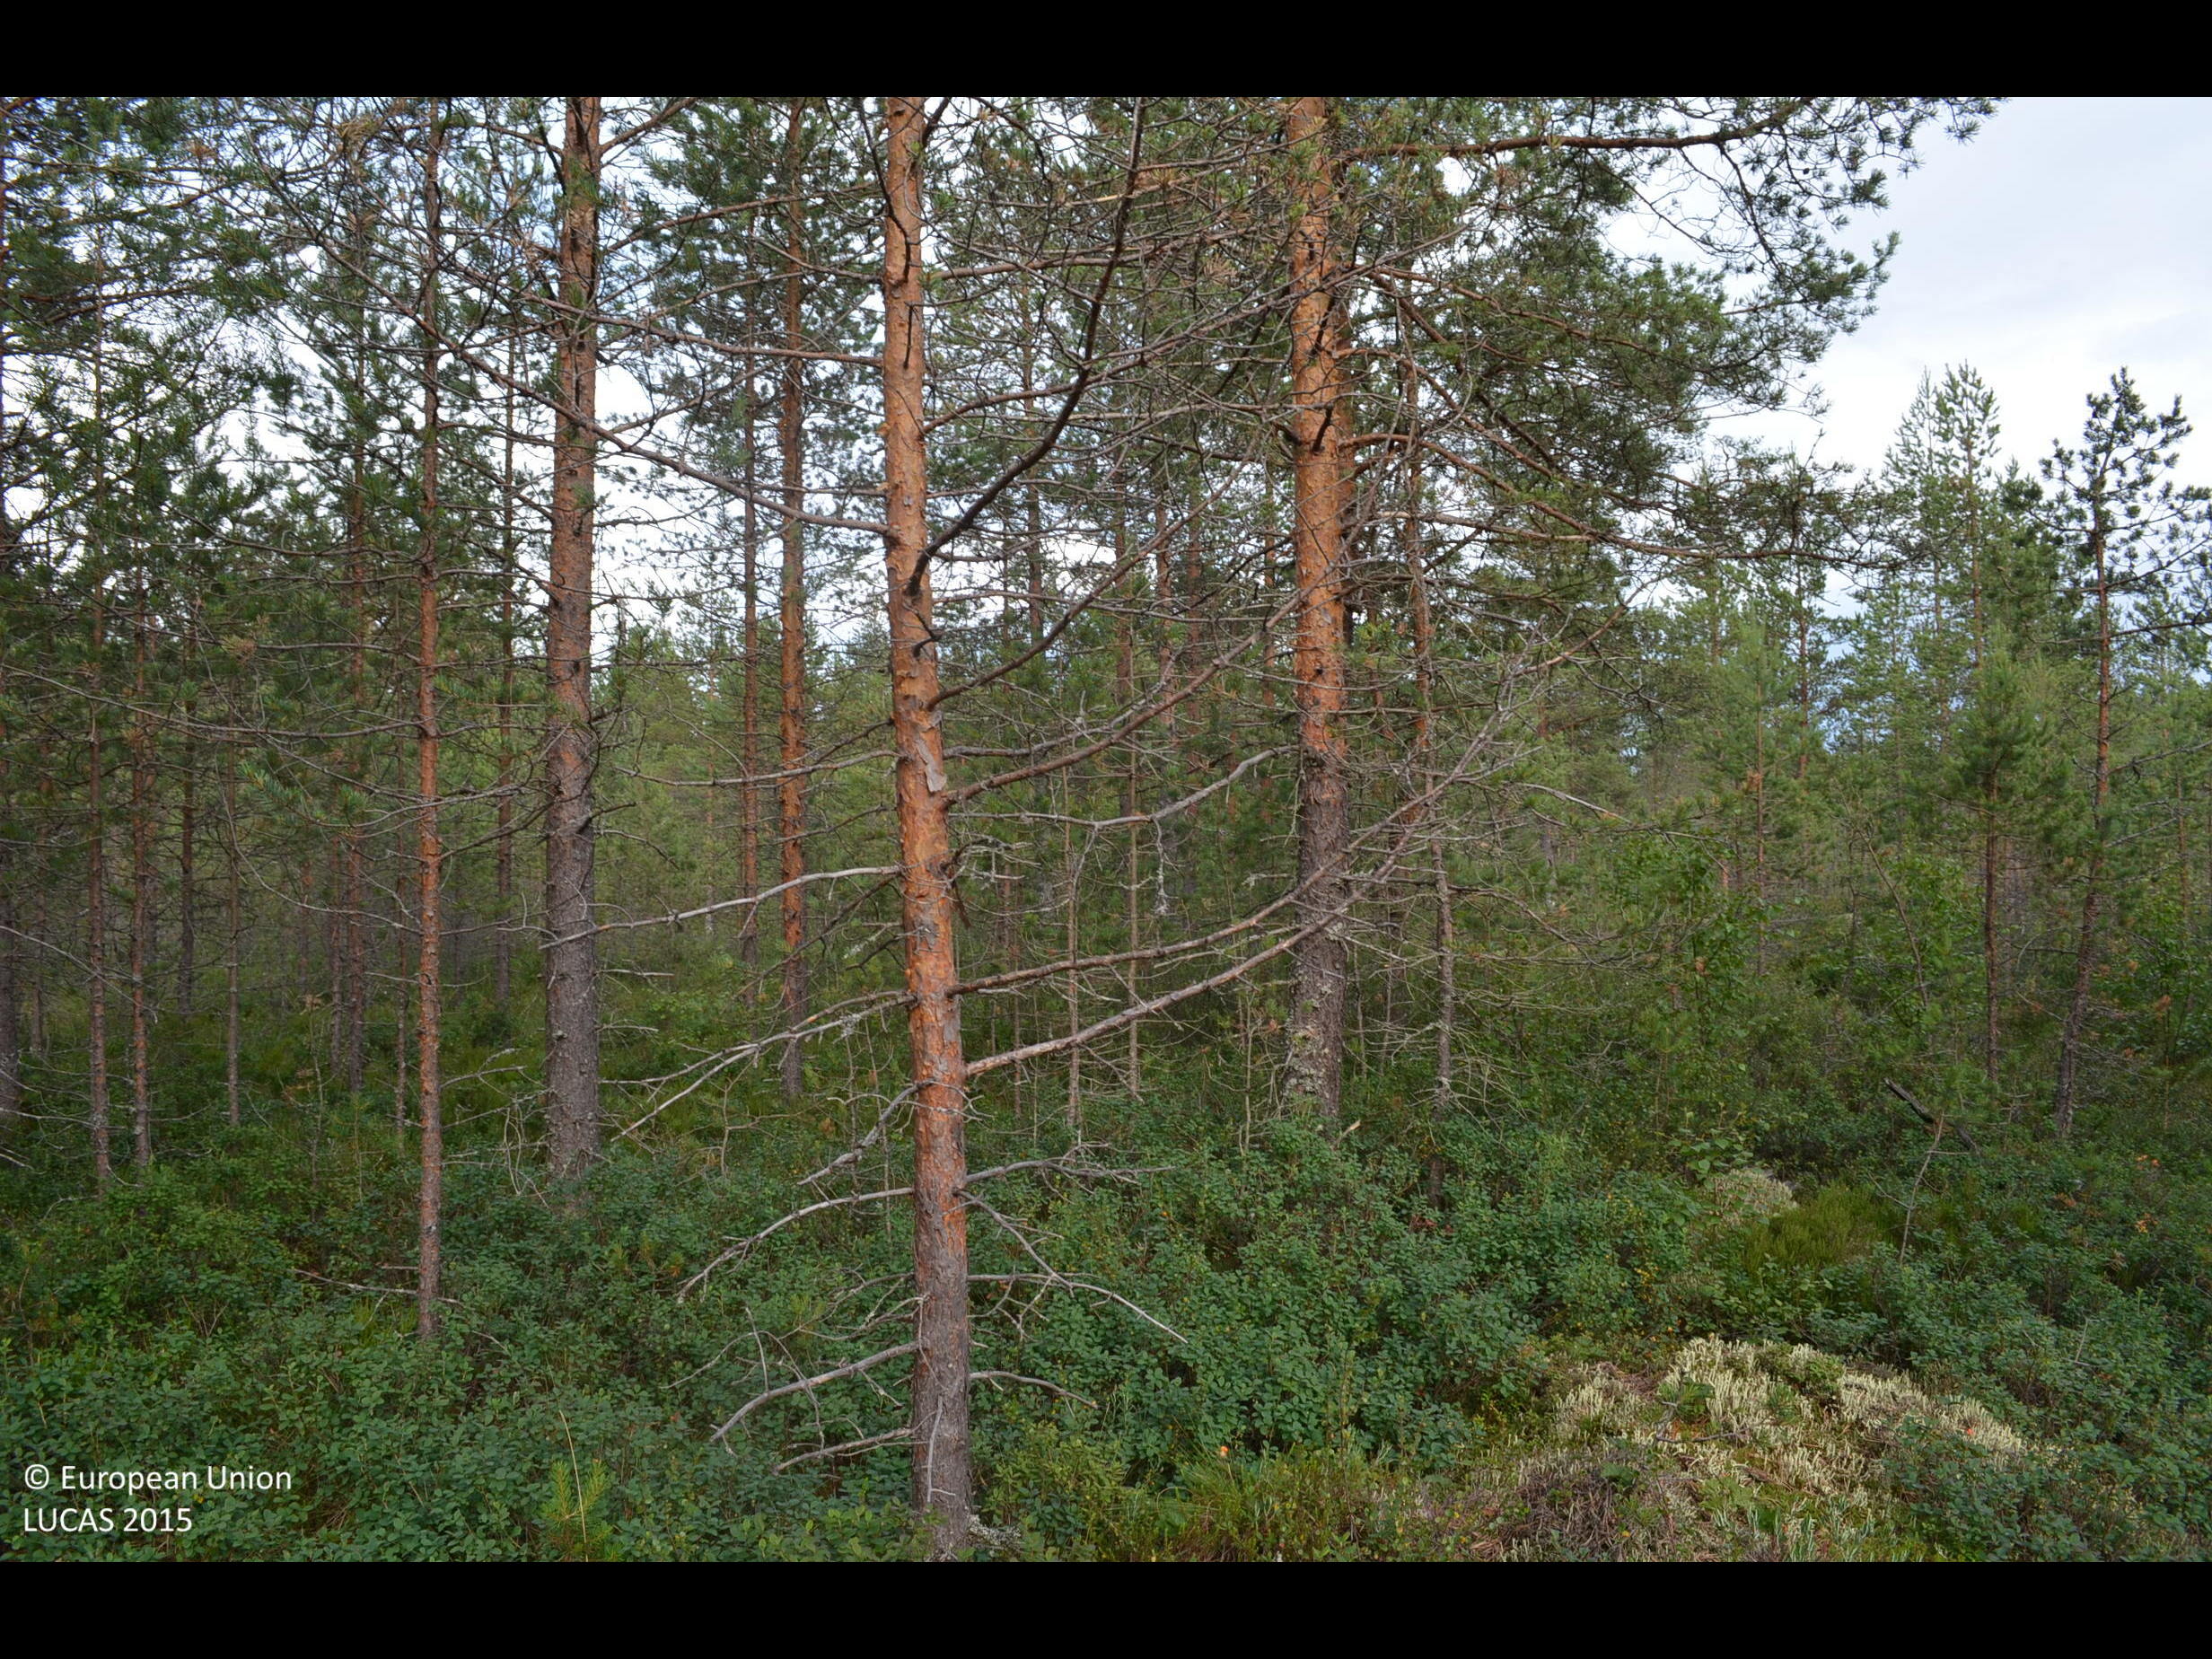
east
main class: Woodland
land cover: Pine dominated coniferous woodland
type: boreal forest
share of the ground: > 75 %
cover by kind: coniferous forest trees 75 %, shrubs 25 %
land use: Forestry
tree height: < 5 m
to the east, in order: Pine dominated coniferous woodland; Ditches and canals; Pine dominated coniferous woodland; Ditches and canals; Pine dominated mixed woodland; Broadleaved woodland; Ditches and canals; Spruce dominated mixed woodland; Ditches and canals; Shrubland with sparse tree cover
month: July
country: FI
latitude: 62.1943
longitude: 23.3887
